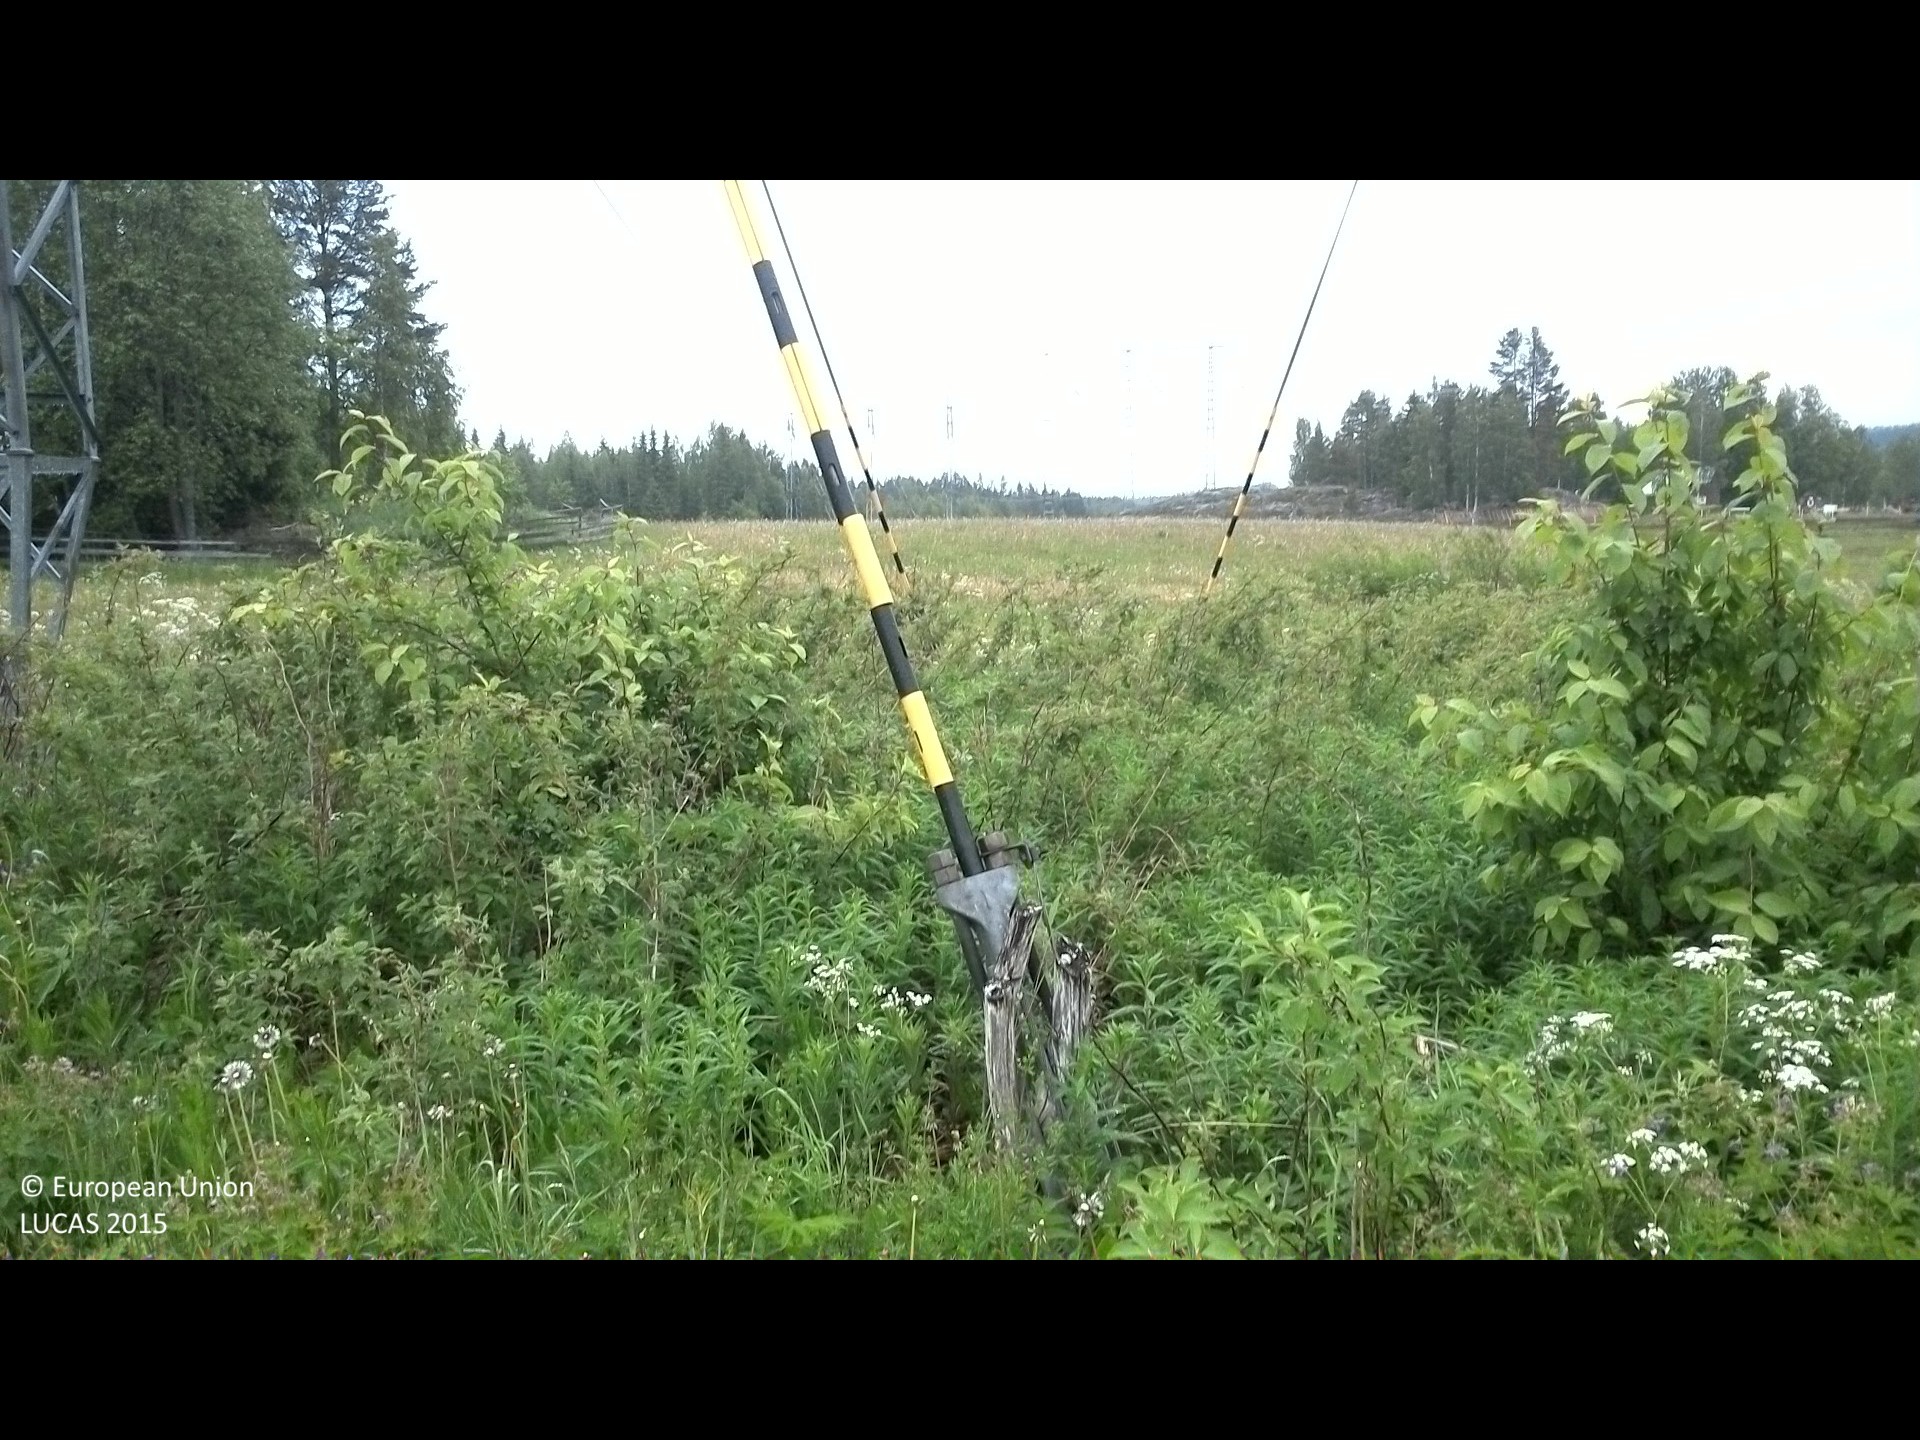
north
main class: Artificial land
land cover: Other artificial areas
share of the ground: > 75 %
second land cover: Other leguminous and mixtures for fodder
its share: > 75 %
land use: Electricity, gas and thermal power distribution
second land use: Agriculture (excluding fallow land and kitchen gardens)
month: June
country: SE
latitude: 62.0189
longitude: 16.9173
